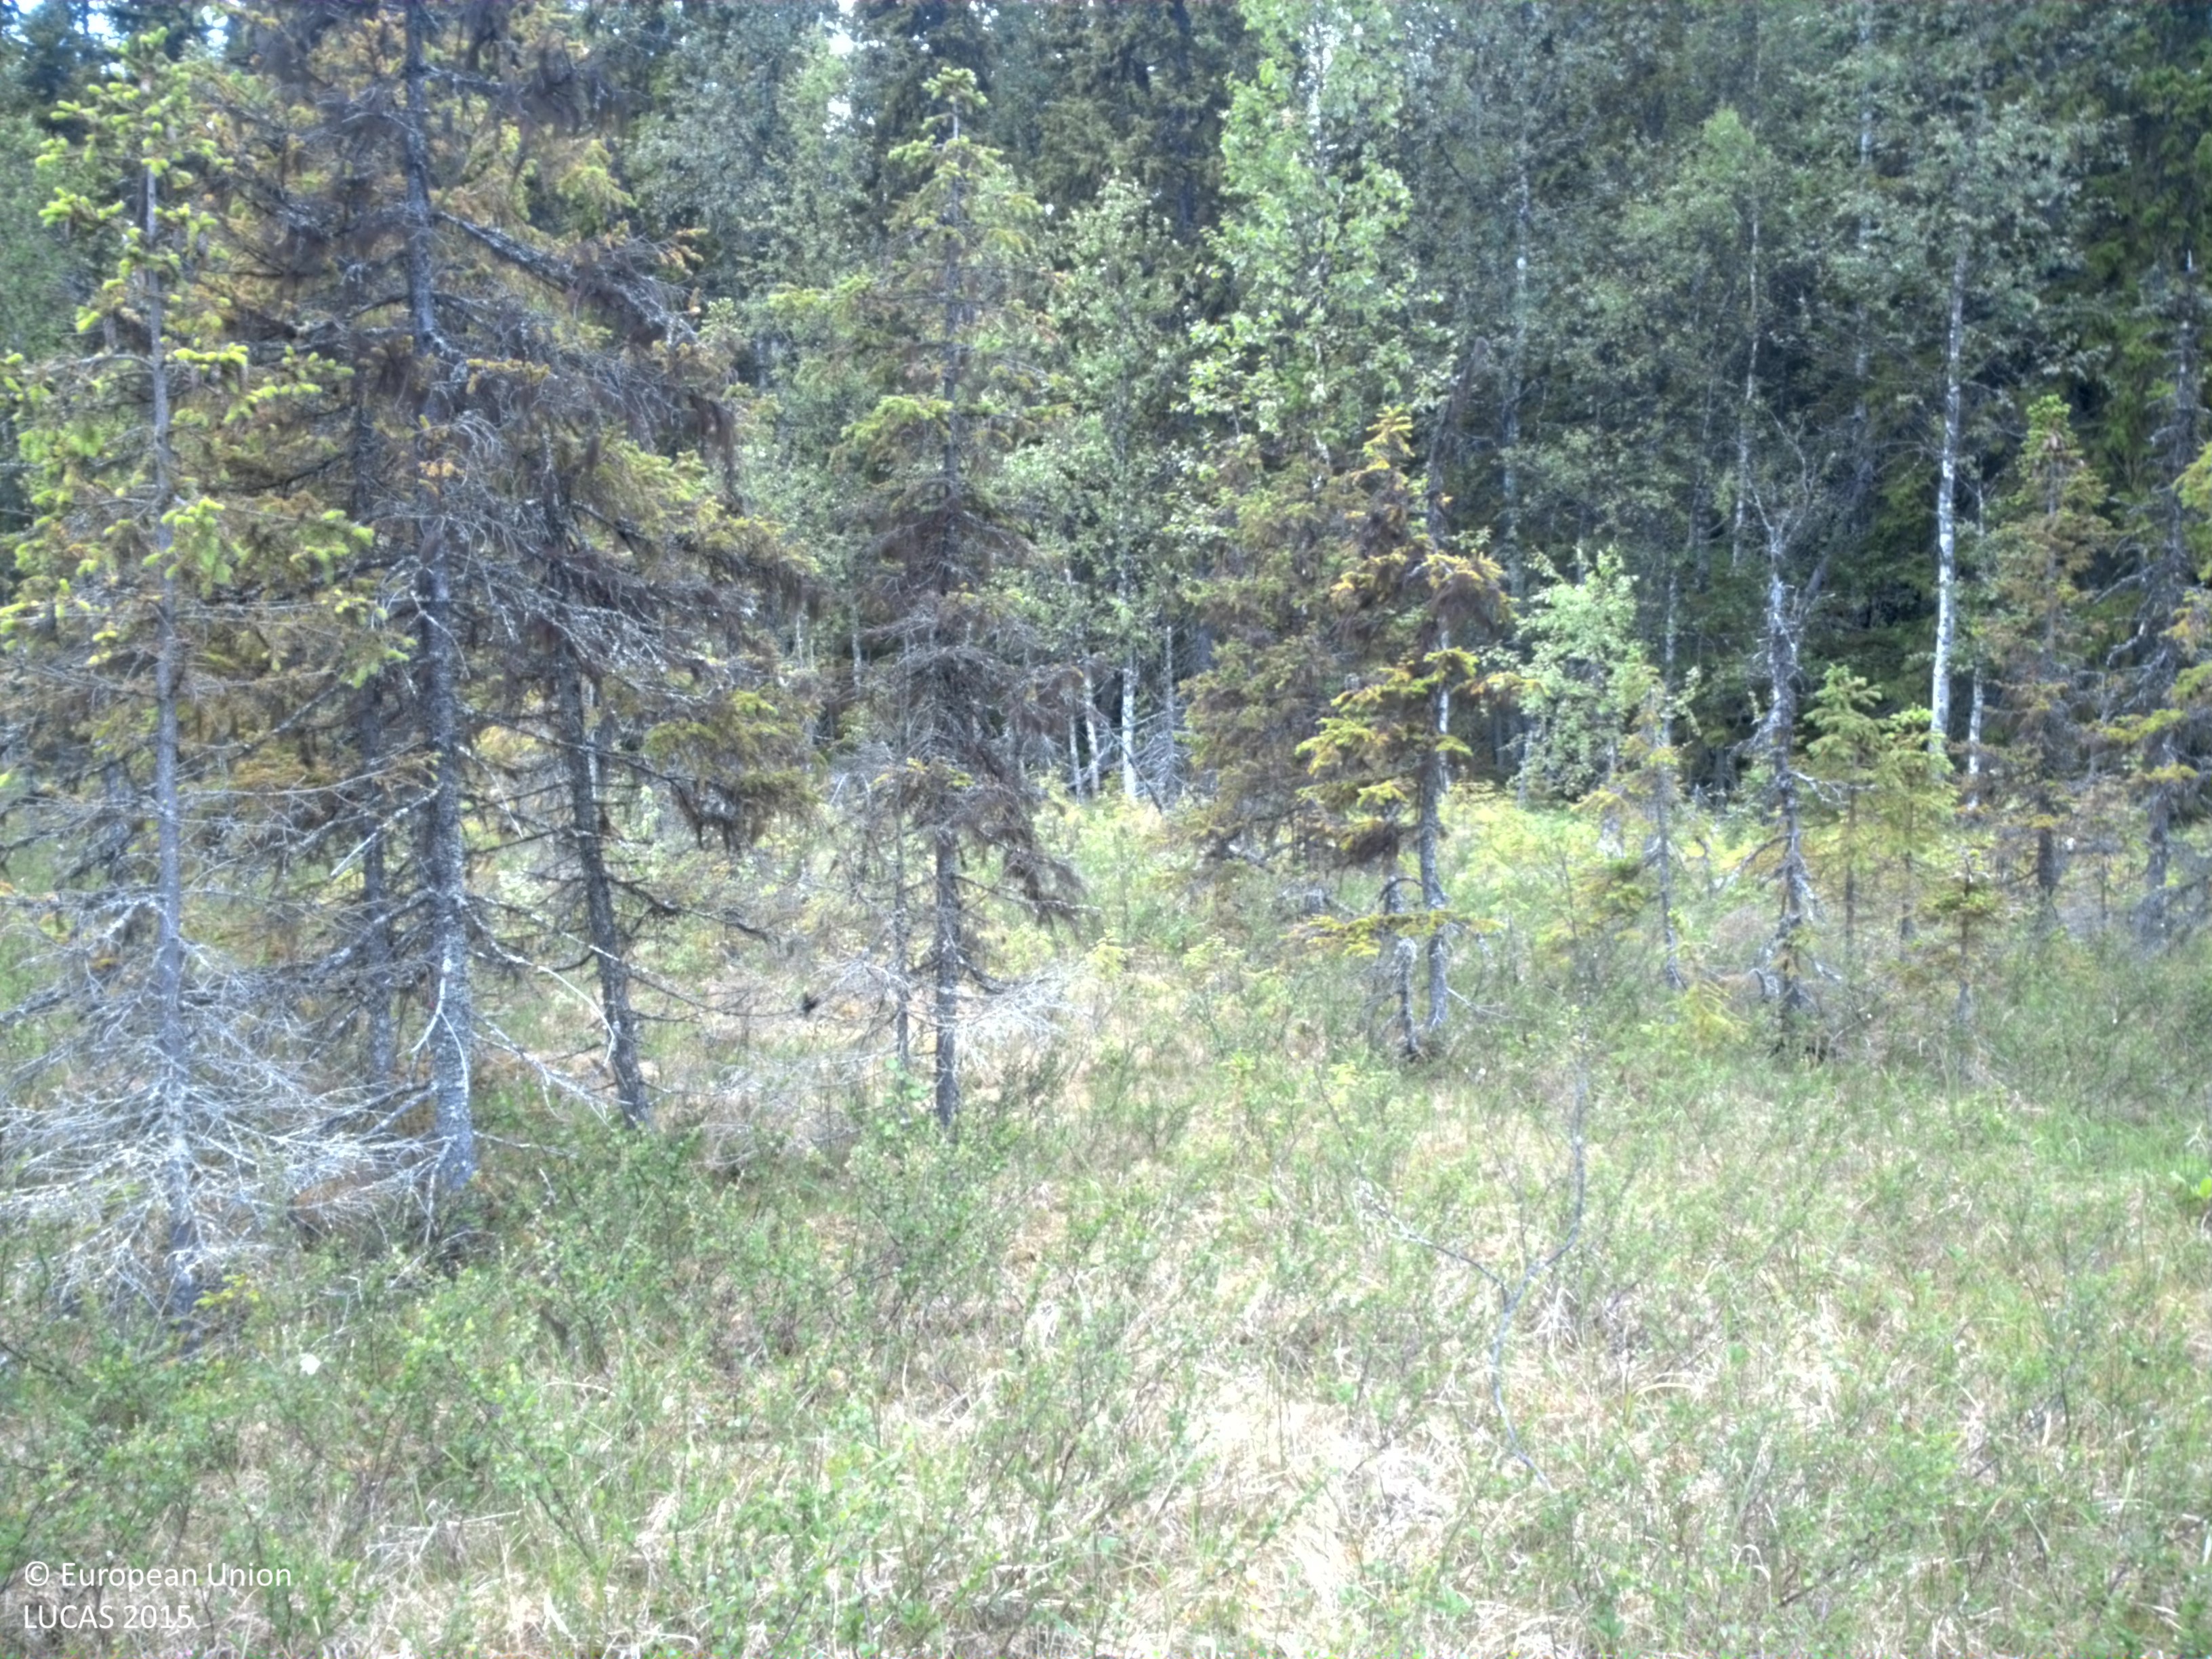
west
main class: Woodland
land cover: Spruce dominated coniferous woodland
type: mire and swamp forests
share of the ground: 10 - 25 %
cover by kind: coniferous forest trees 50 %, shrubs 25 %, herbaceous plants 25 %
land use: Forestry
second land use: Amenities, museums, leisure
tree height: < 5 m
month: July
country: SE
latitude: 64.4754
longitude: 18.2255
